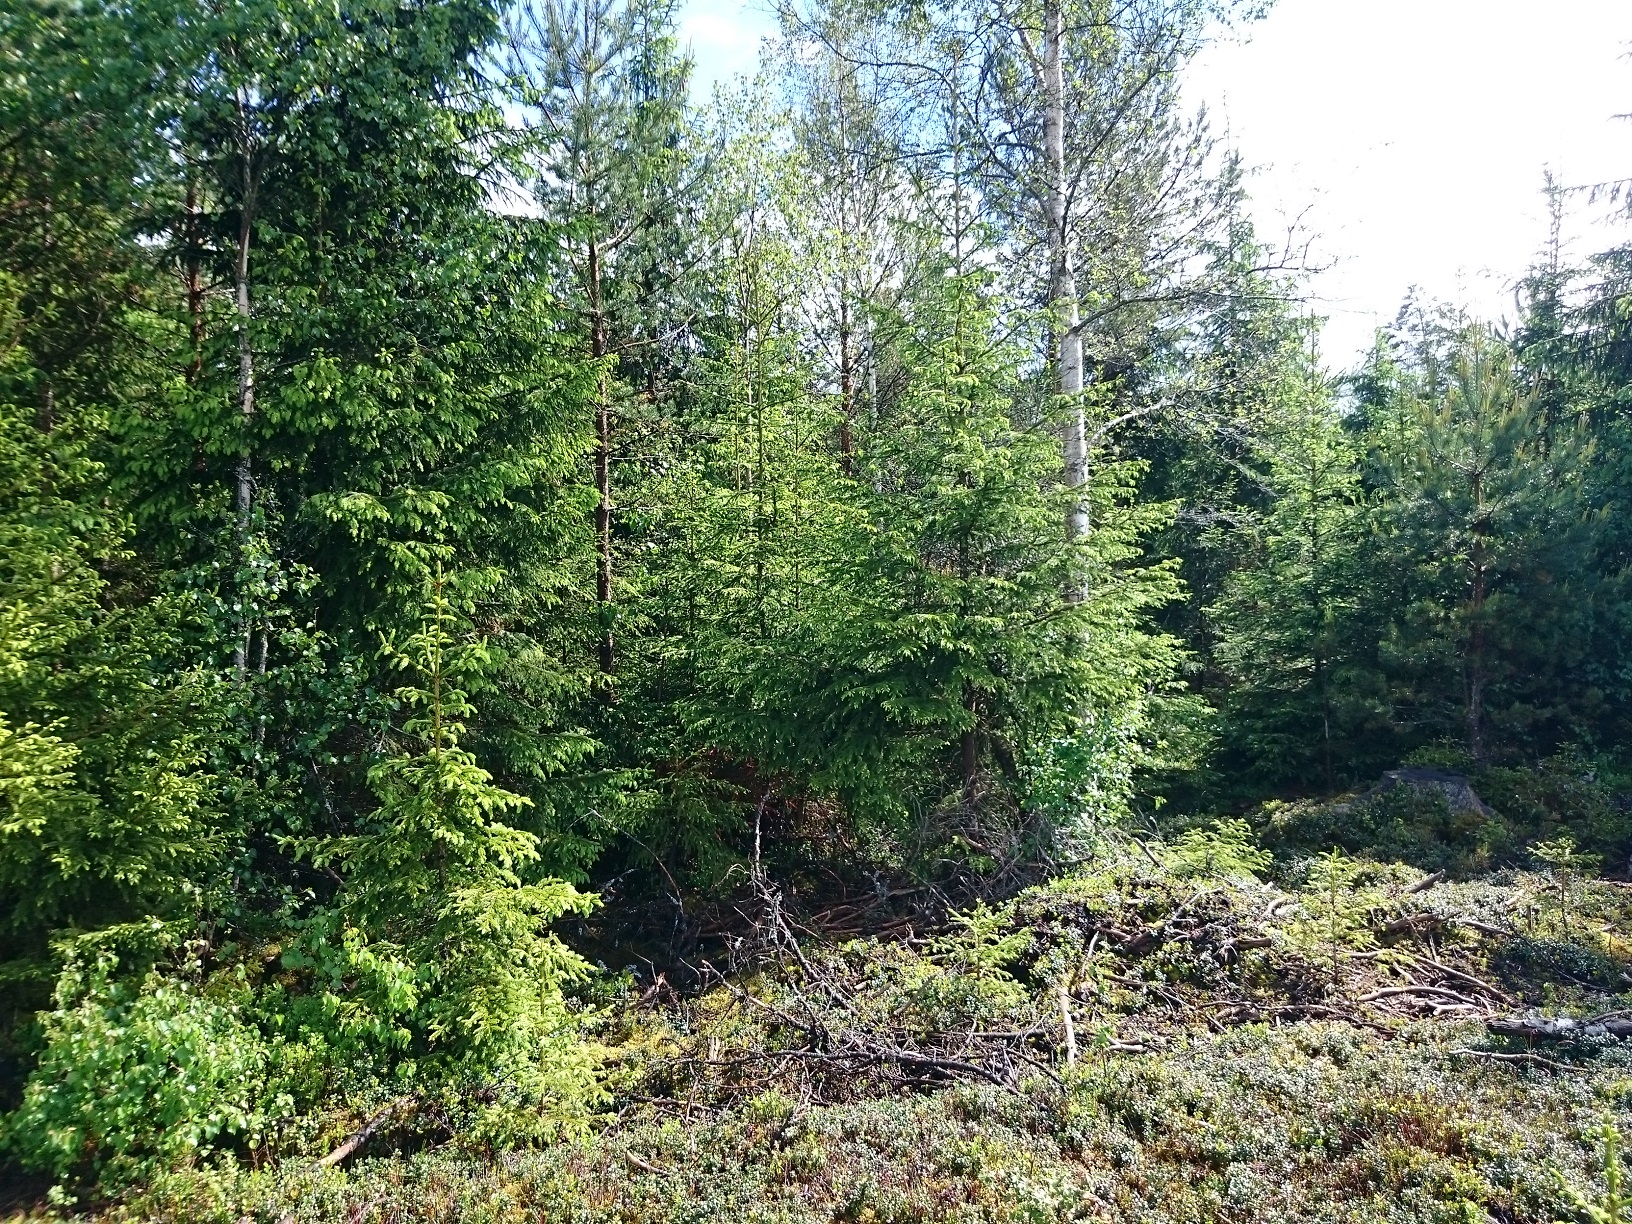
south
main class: Woodland
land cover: Spruce dominated mixed woodland
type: boreal forest
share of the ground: 25 - 50 %
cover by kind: shrubs 30 %, coniferous forest trees 25 %, broadleaved forest trees 25 %, herbaceous plants 10 %, lichens and mosses 10 %
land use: Forestry
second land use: Amenities, museums, leisure
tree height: < 5 m
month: June
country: SE
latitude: 56.9793
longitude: 14.3238
